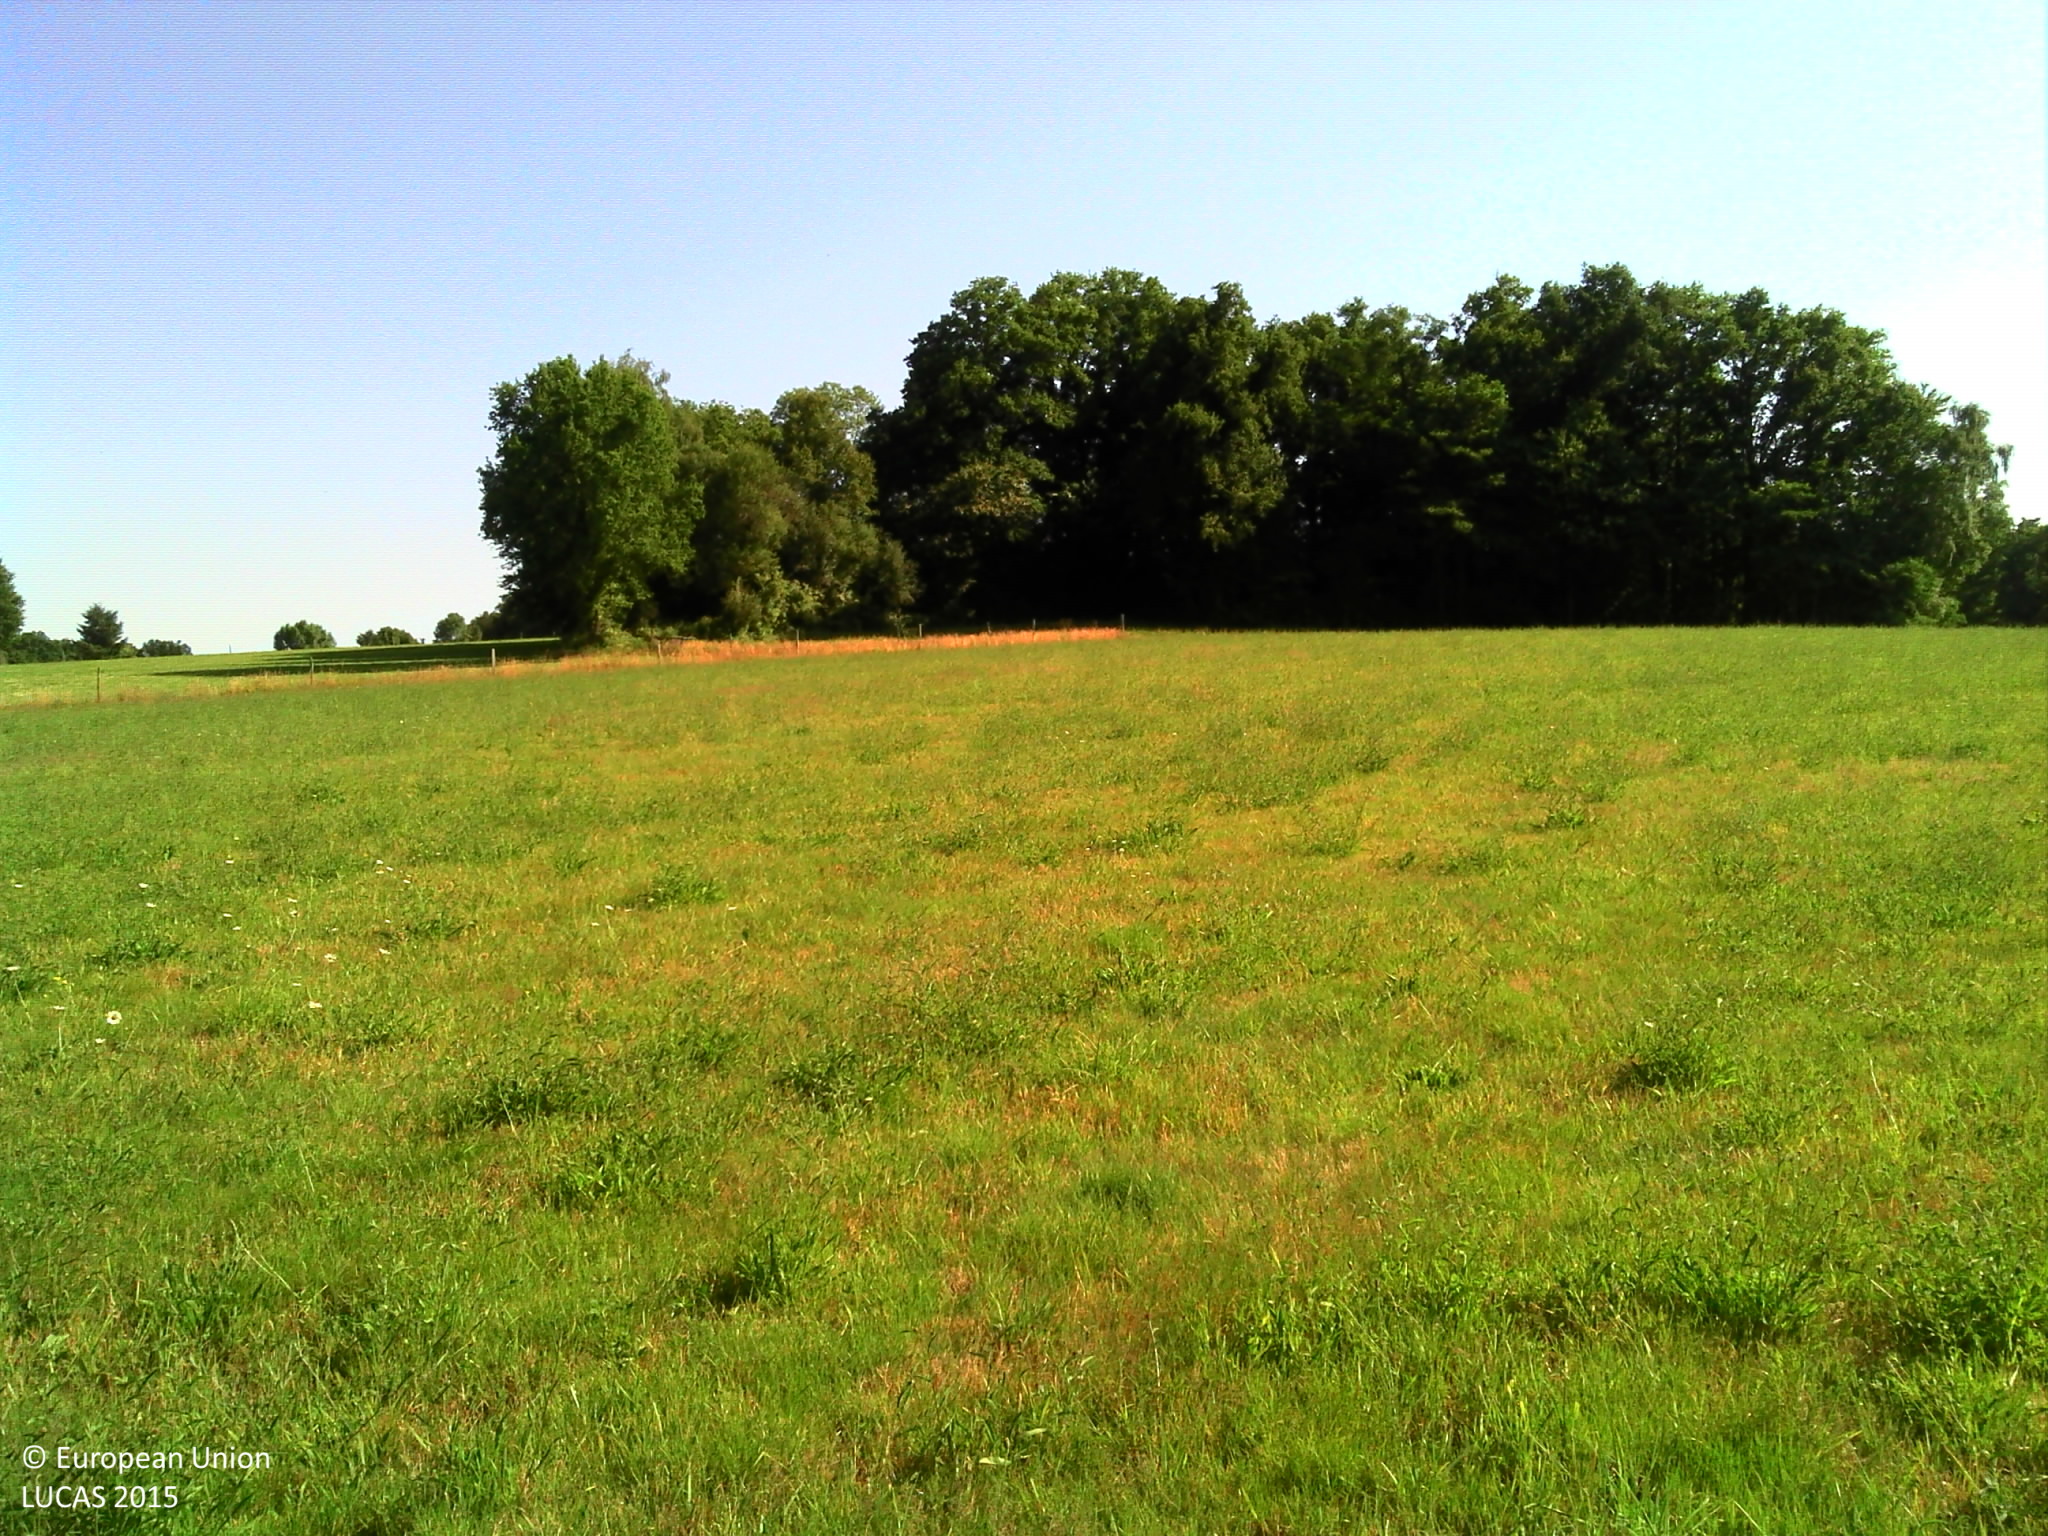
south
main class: Grassland
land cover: Grassland without tree/shrub cover
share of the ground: > 75 %
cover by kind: herbaceous plants 100 %
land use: Agriculture (excluding fallow land and kitchen gardens)
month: June
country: FR
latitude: 45.7564
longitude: 0.6146
